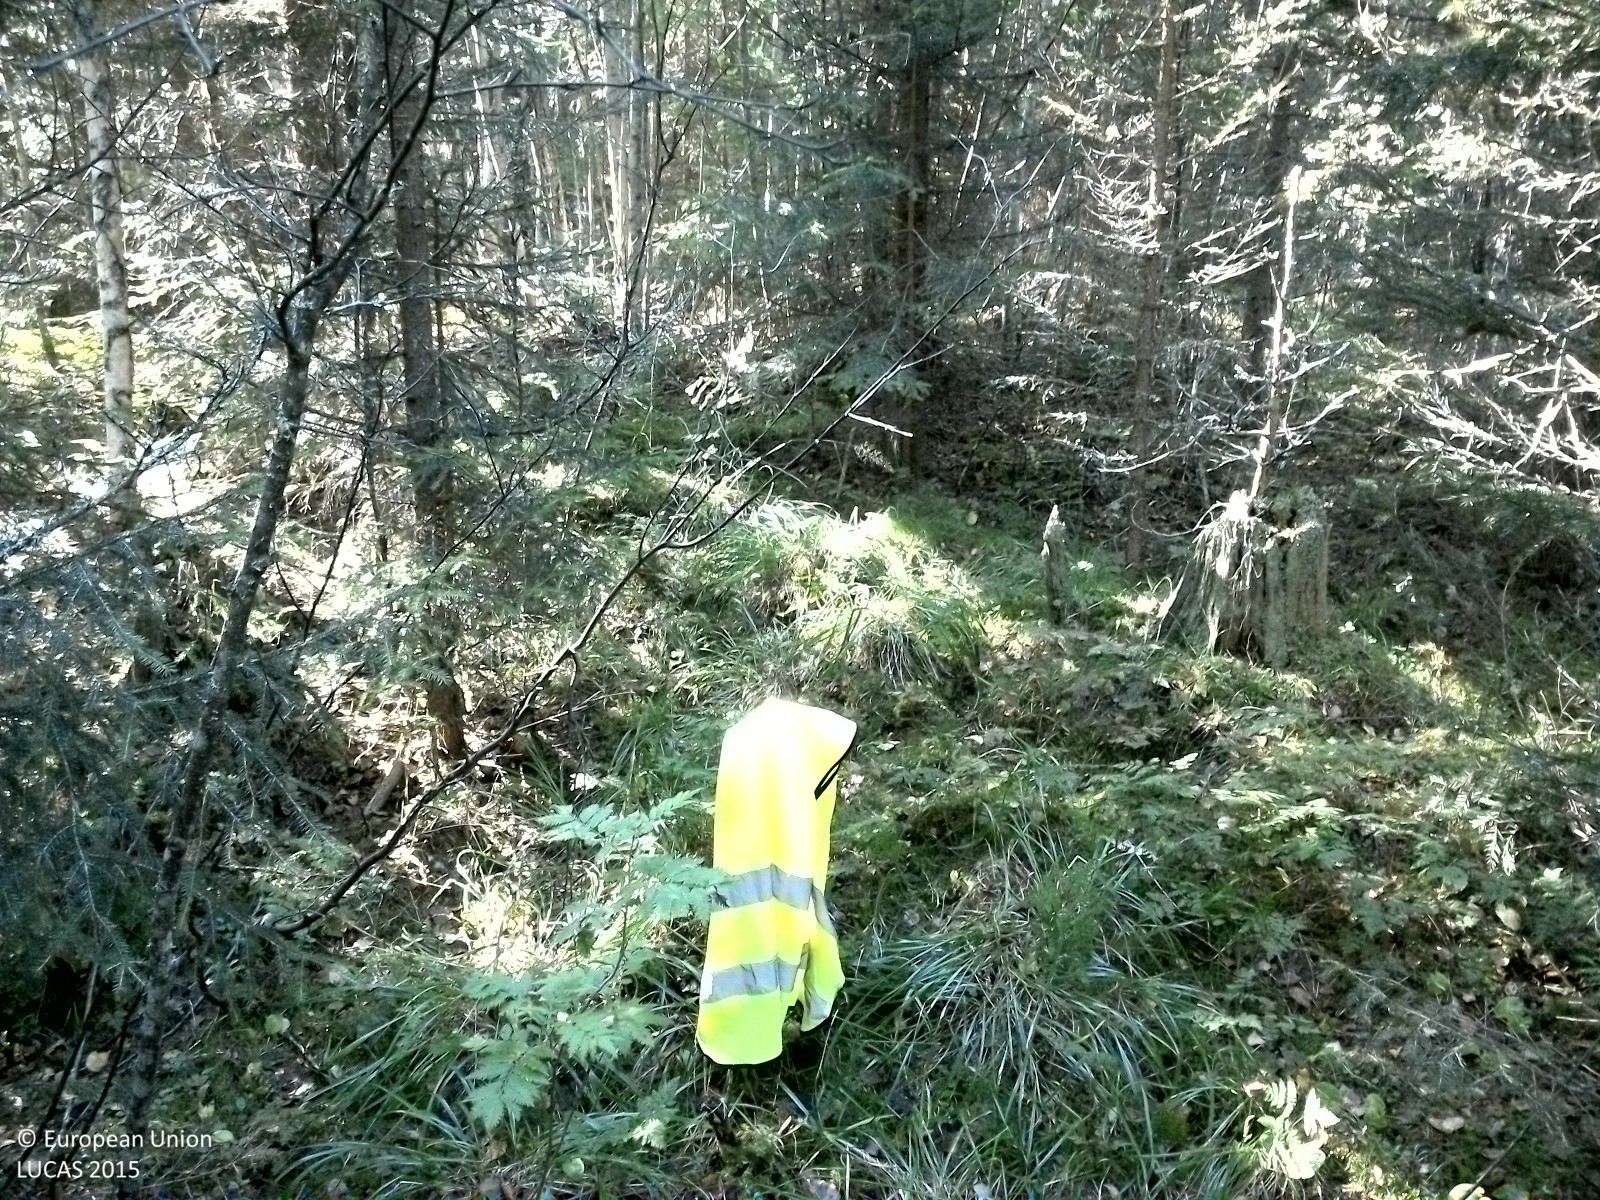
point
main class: Woodland
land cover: Spruce dominated mixed woodland
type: boreal forest
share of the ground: > 75 %
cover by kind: coniferous forest trees 45 %, broadleaved forest trees 25 %, herbaceous plants 15 %, lichens and mosses 15 %
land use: Forestry
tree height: > 5 m
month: September
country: SE
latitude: 62.5334
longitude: 16.3340
